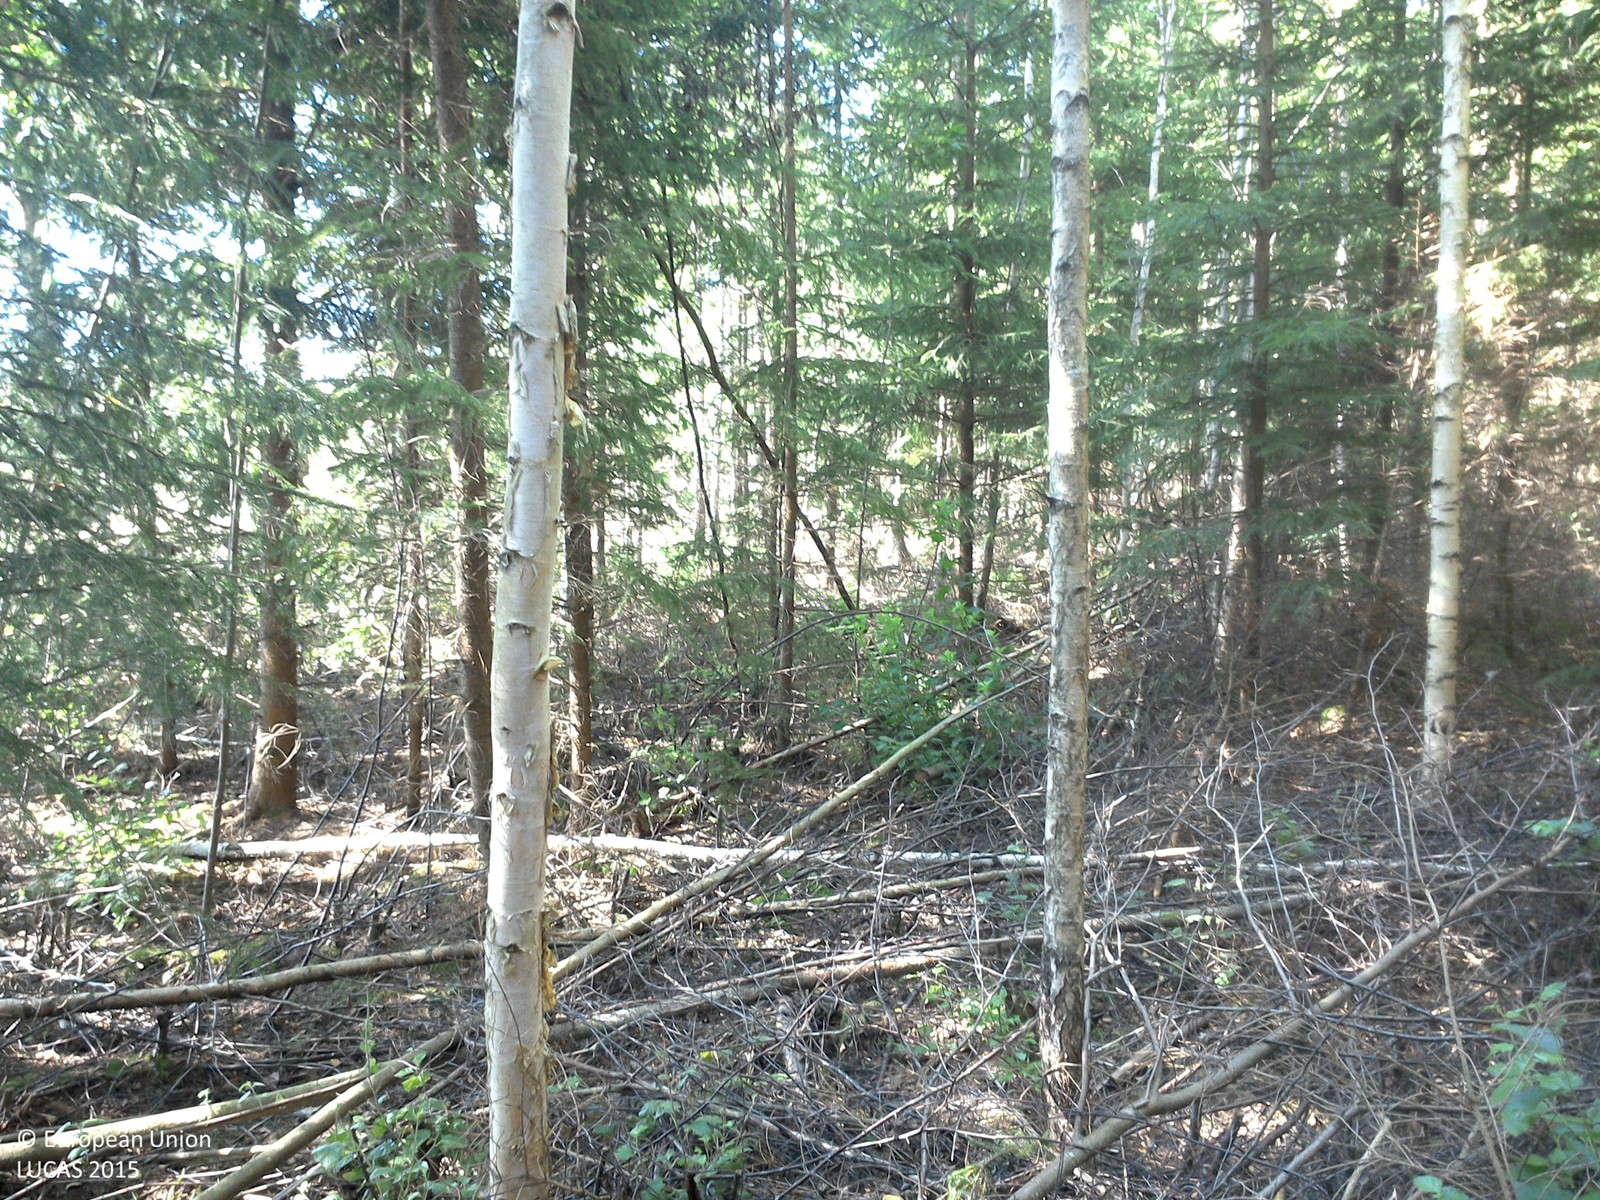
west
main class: Woodland
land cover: Spruce dominated mixed woodland
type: boreal forest
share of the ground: > 75 %
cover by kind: coniferous forest trees 55 %, broadleaved forest trees 20 %, lichens and mosses 15 %, herbaceous plants 10 %
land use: Forestry
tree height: > 5 m
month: August
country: SE
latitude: 57.9673
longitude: 15.3878
